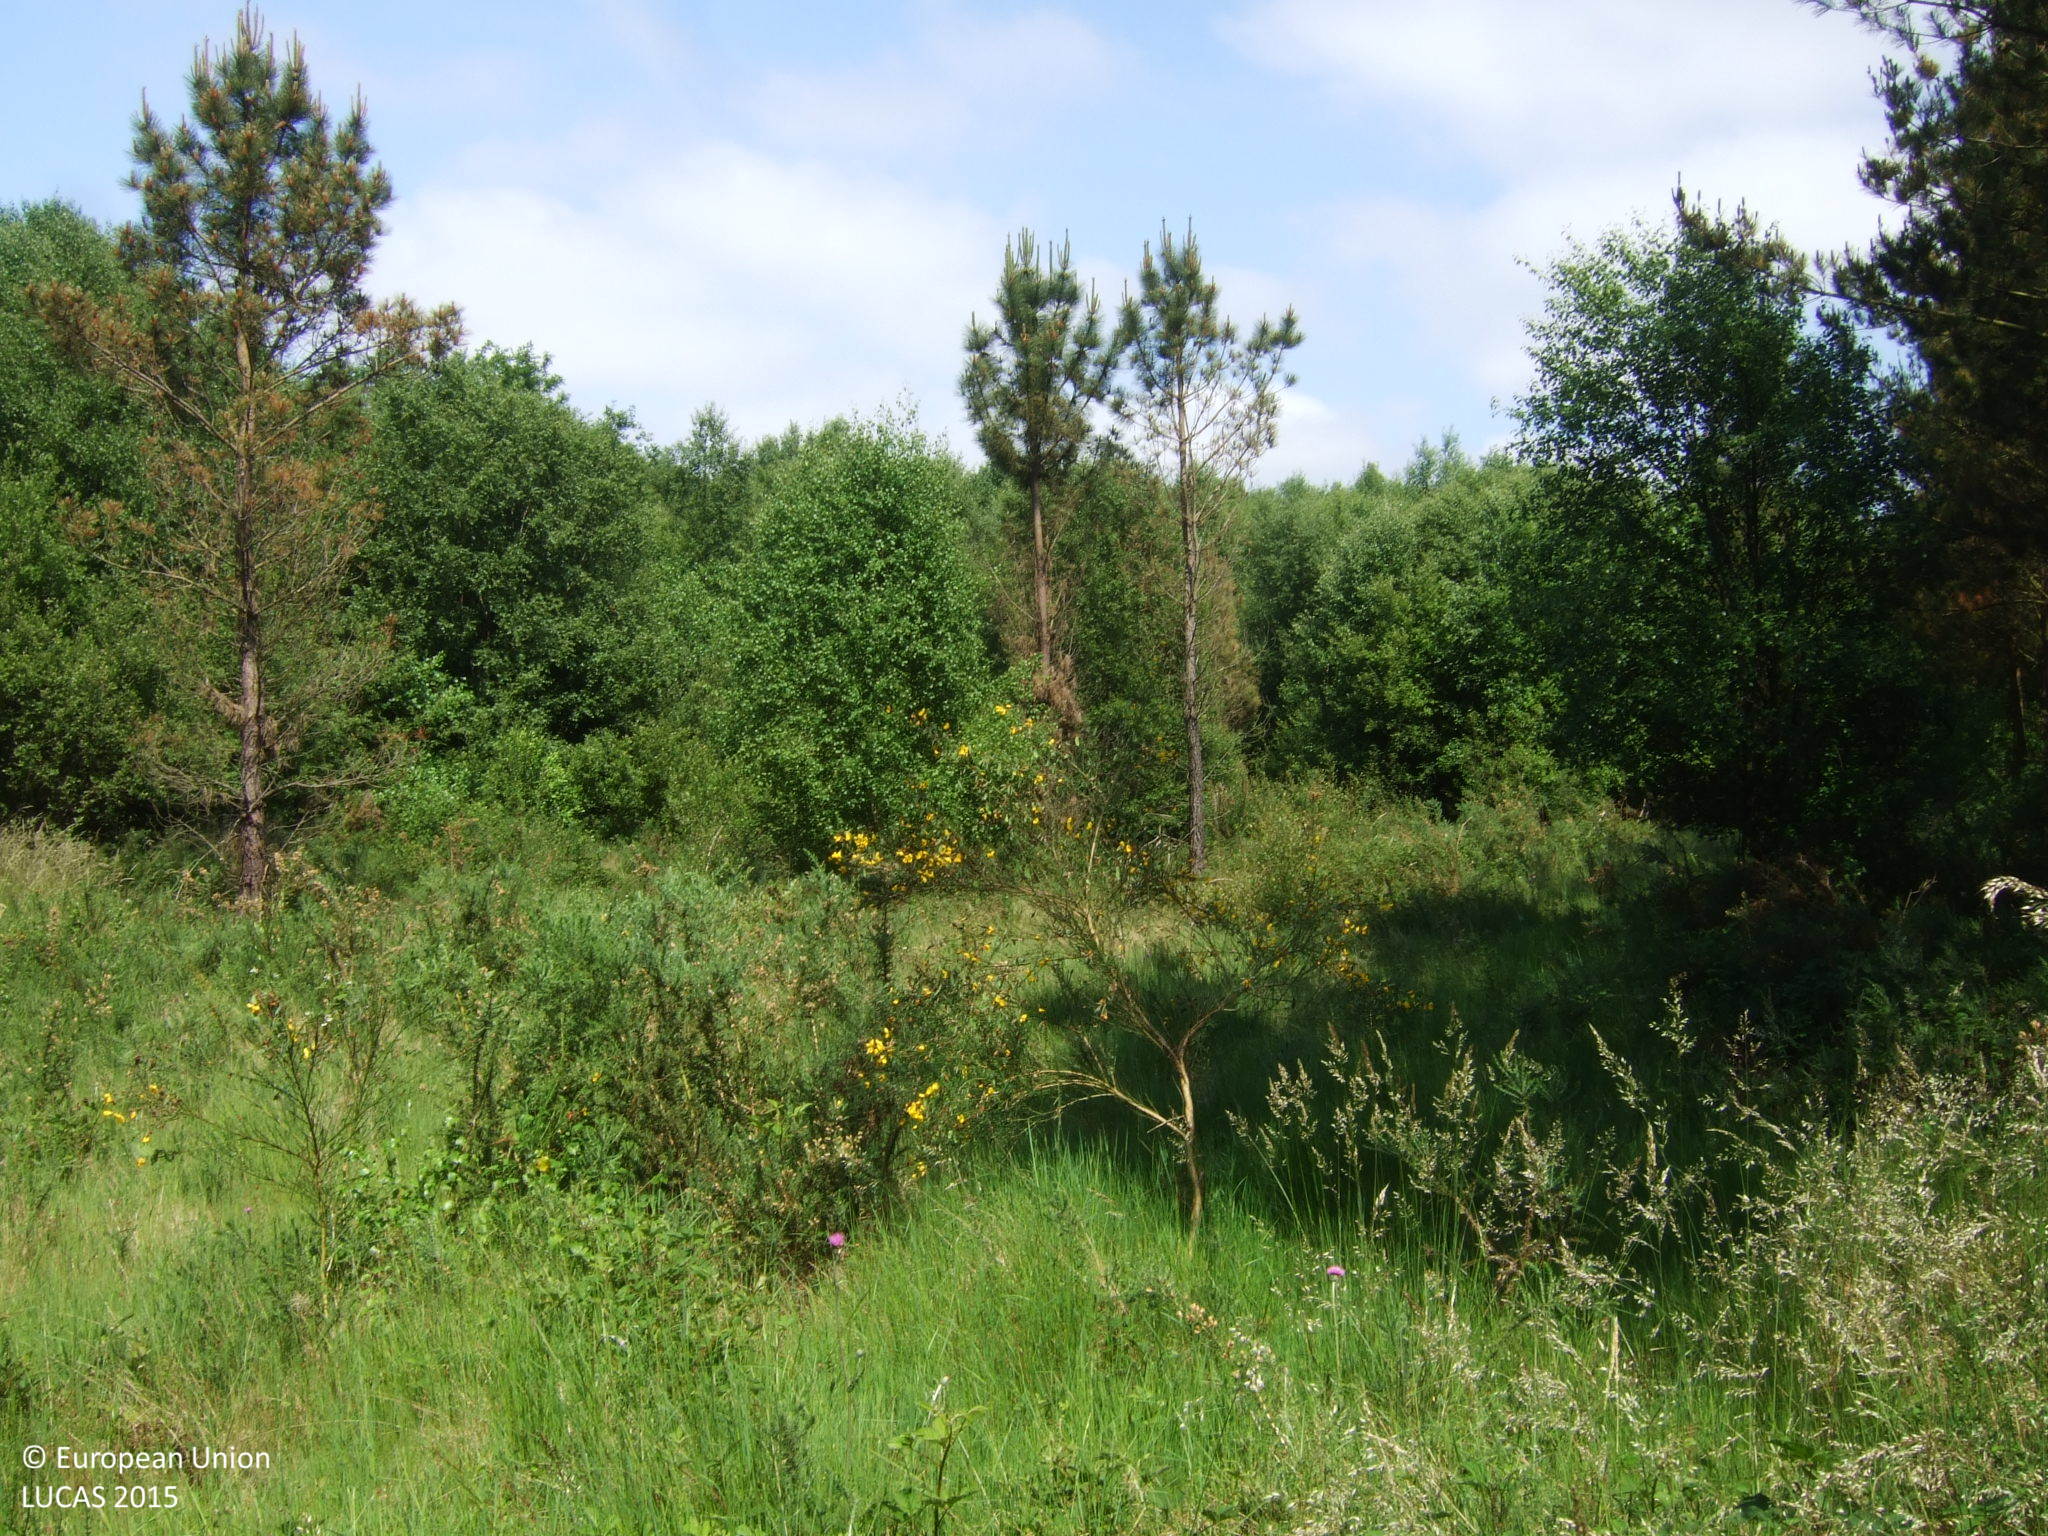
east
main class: Woodland
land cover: Pine dominated coniferous woodland
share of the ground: 25 - 50 %
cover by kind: shrubs 60 %, coniferous forest trees 40 %
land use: Forestry
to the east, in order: Pine dominated coniferous woodland; Broadleaved woodland; Tracks; Ditches and canals; Groves; Grassland without tree/shrub cover; Groves; Grassland without tree/shrub cover
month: June
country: ES
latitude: 43.2657
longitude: -7.4358
